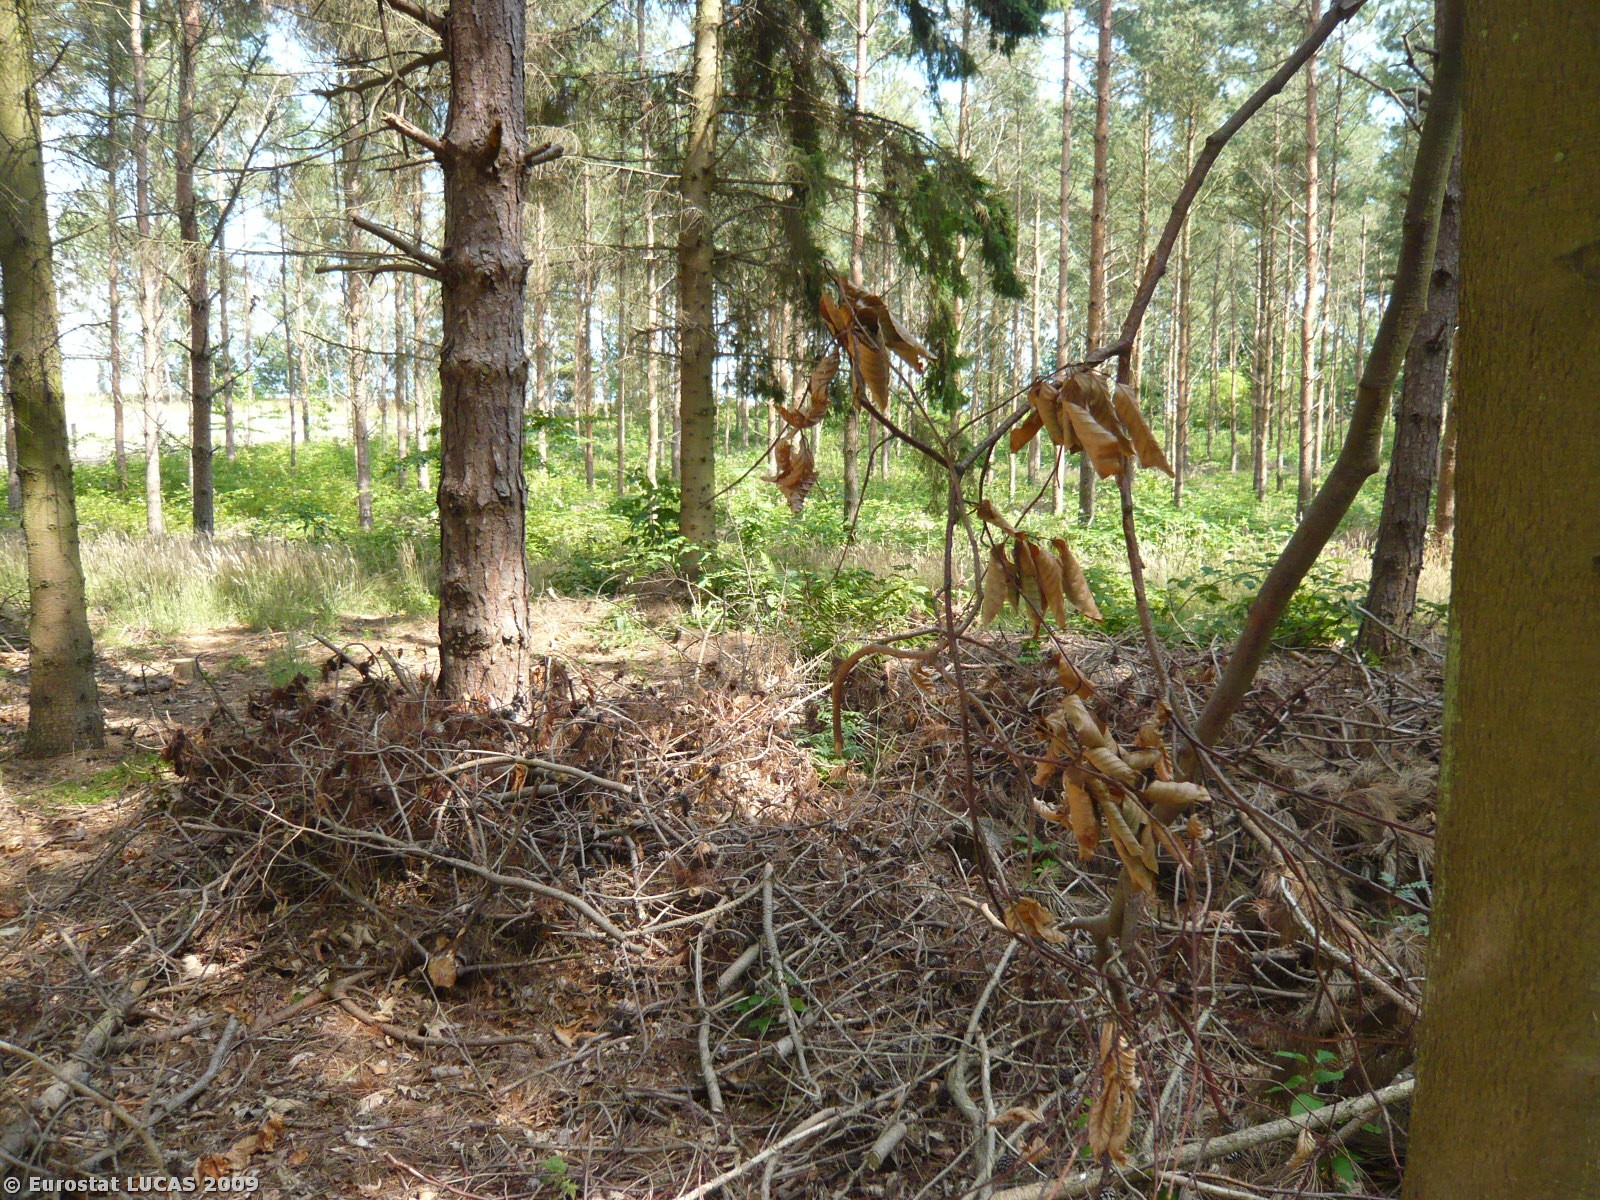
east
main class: Woodland
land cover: Coniferous woodland
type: hemiboreal forest and nemoral coniferous forest and mixed broadleaved-coniferous forest
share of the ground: > 75 %
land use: Forestry
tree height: > 5 m
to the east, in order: Coniferous woodland; Broadleaved woodland; Tracks; Grass margins; Barley
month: July
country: DK
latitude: 55.9242
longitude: 11.7426
